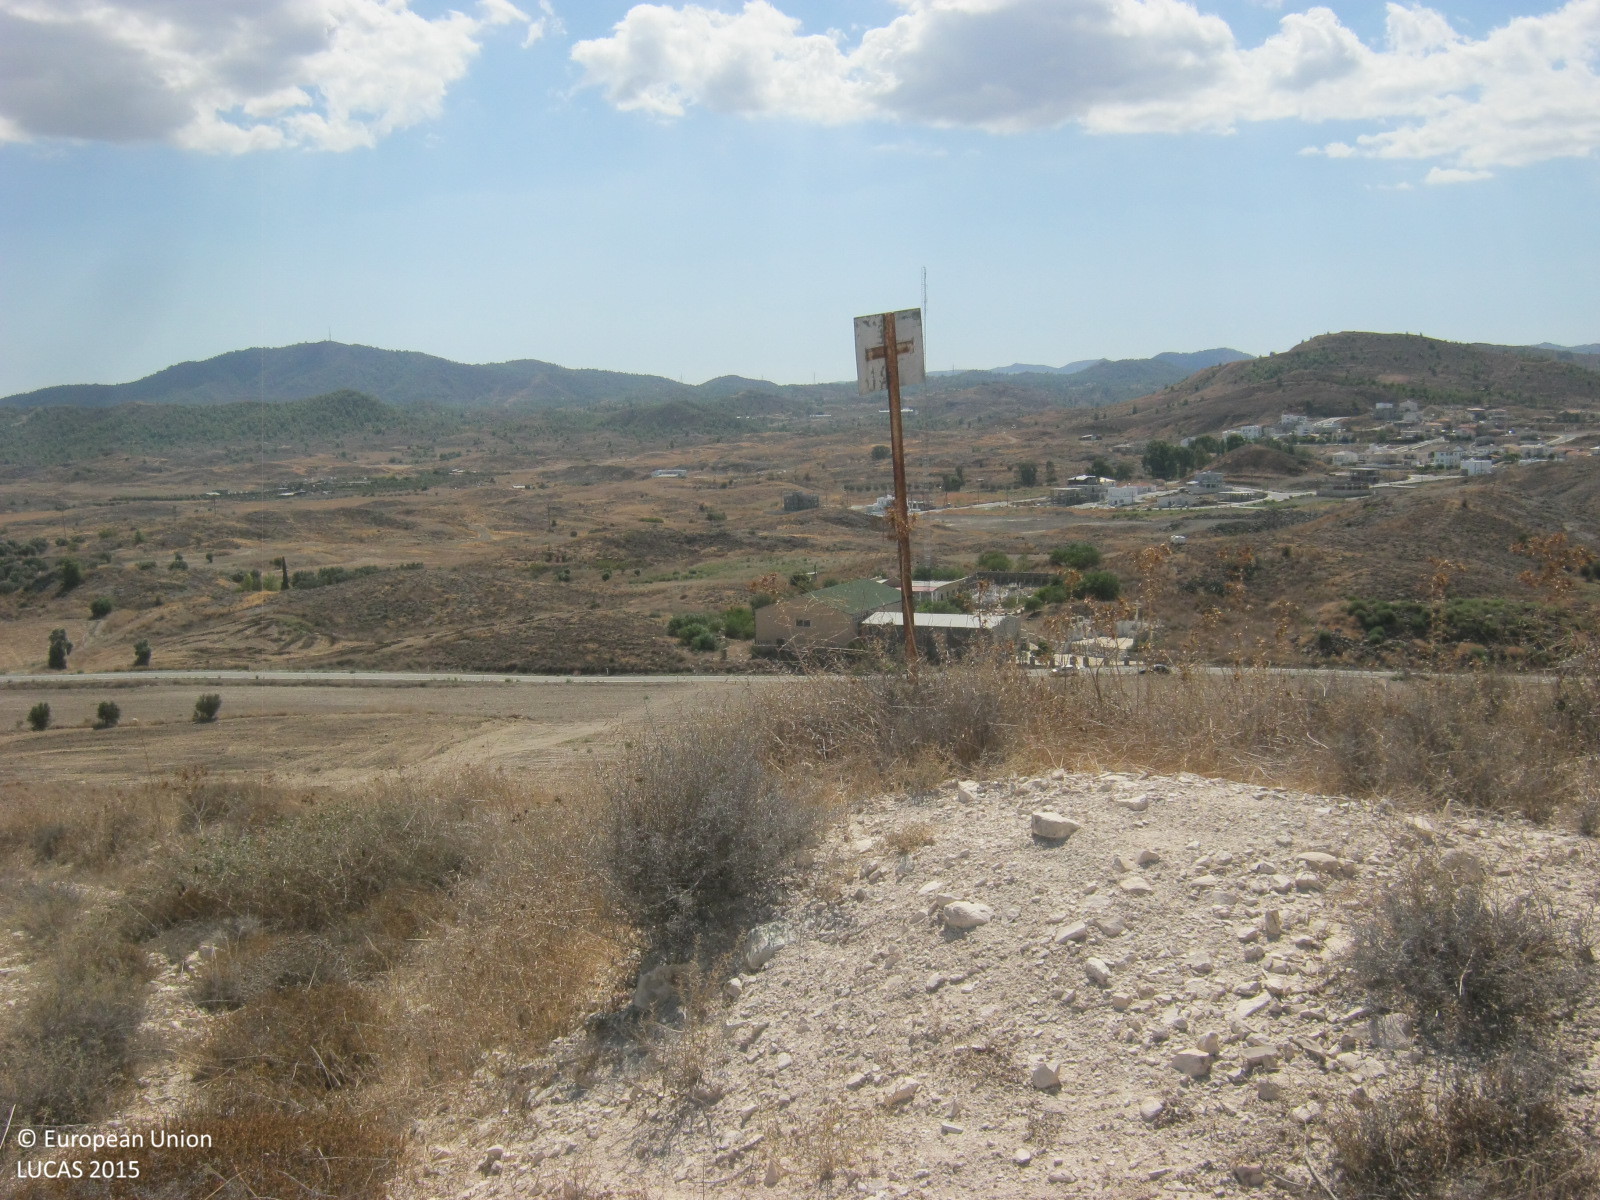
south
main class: Grassland
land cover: Grassland without tree/shrub cover
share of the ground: 25 - 50 %
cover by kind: unconsolidated bare surface 55 %, herbaceous plants 45 %
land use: Semi-natural and natural areas not in use
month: April
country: CY
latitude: 34.9954
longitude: 33.3832
